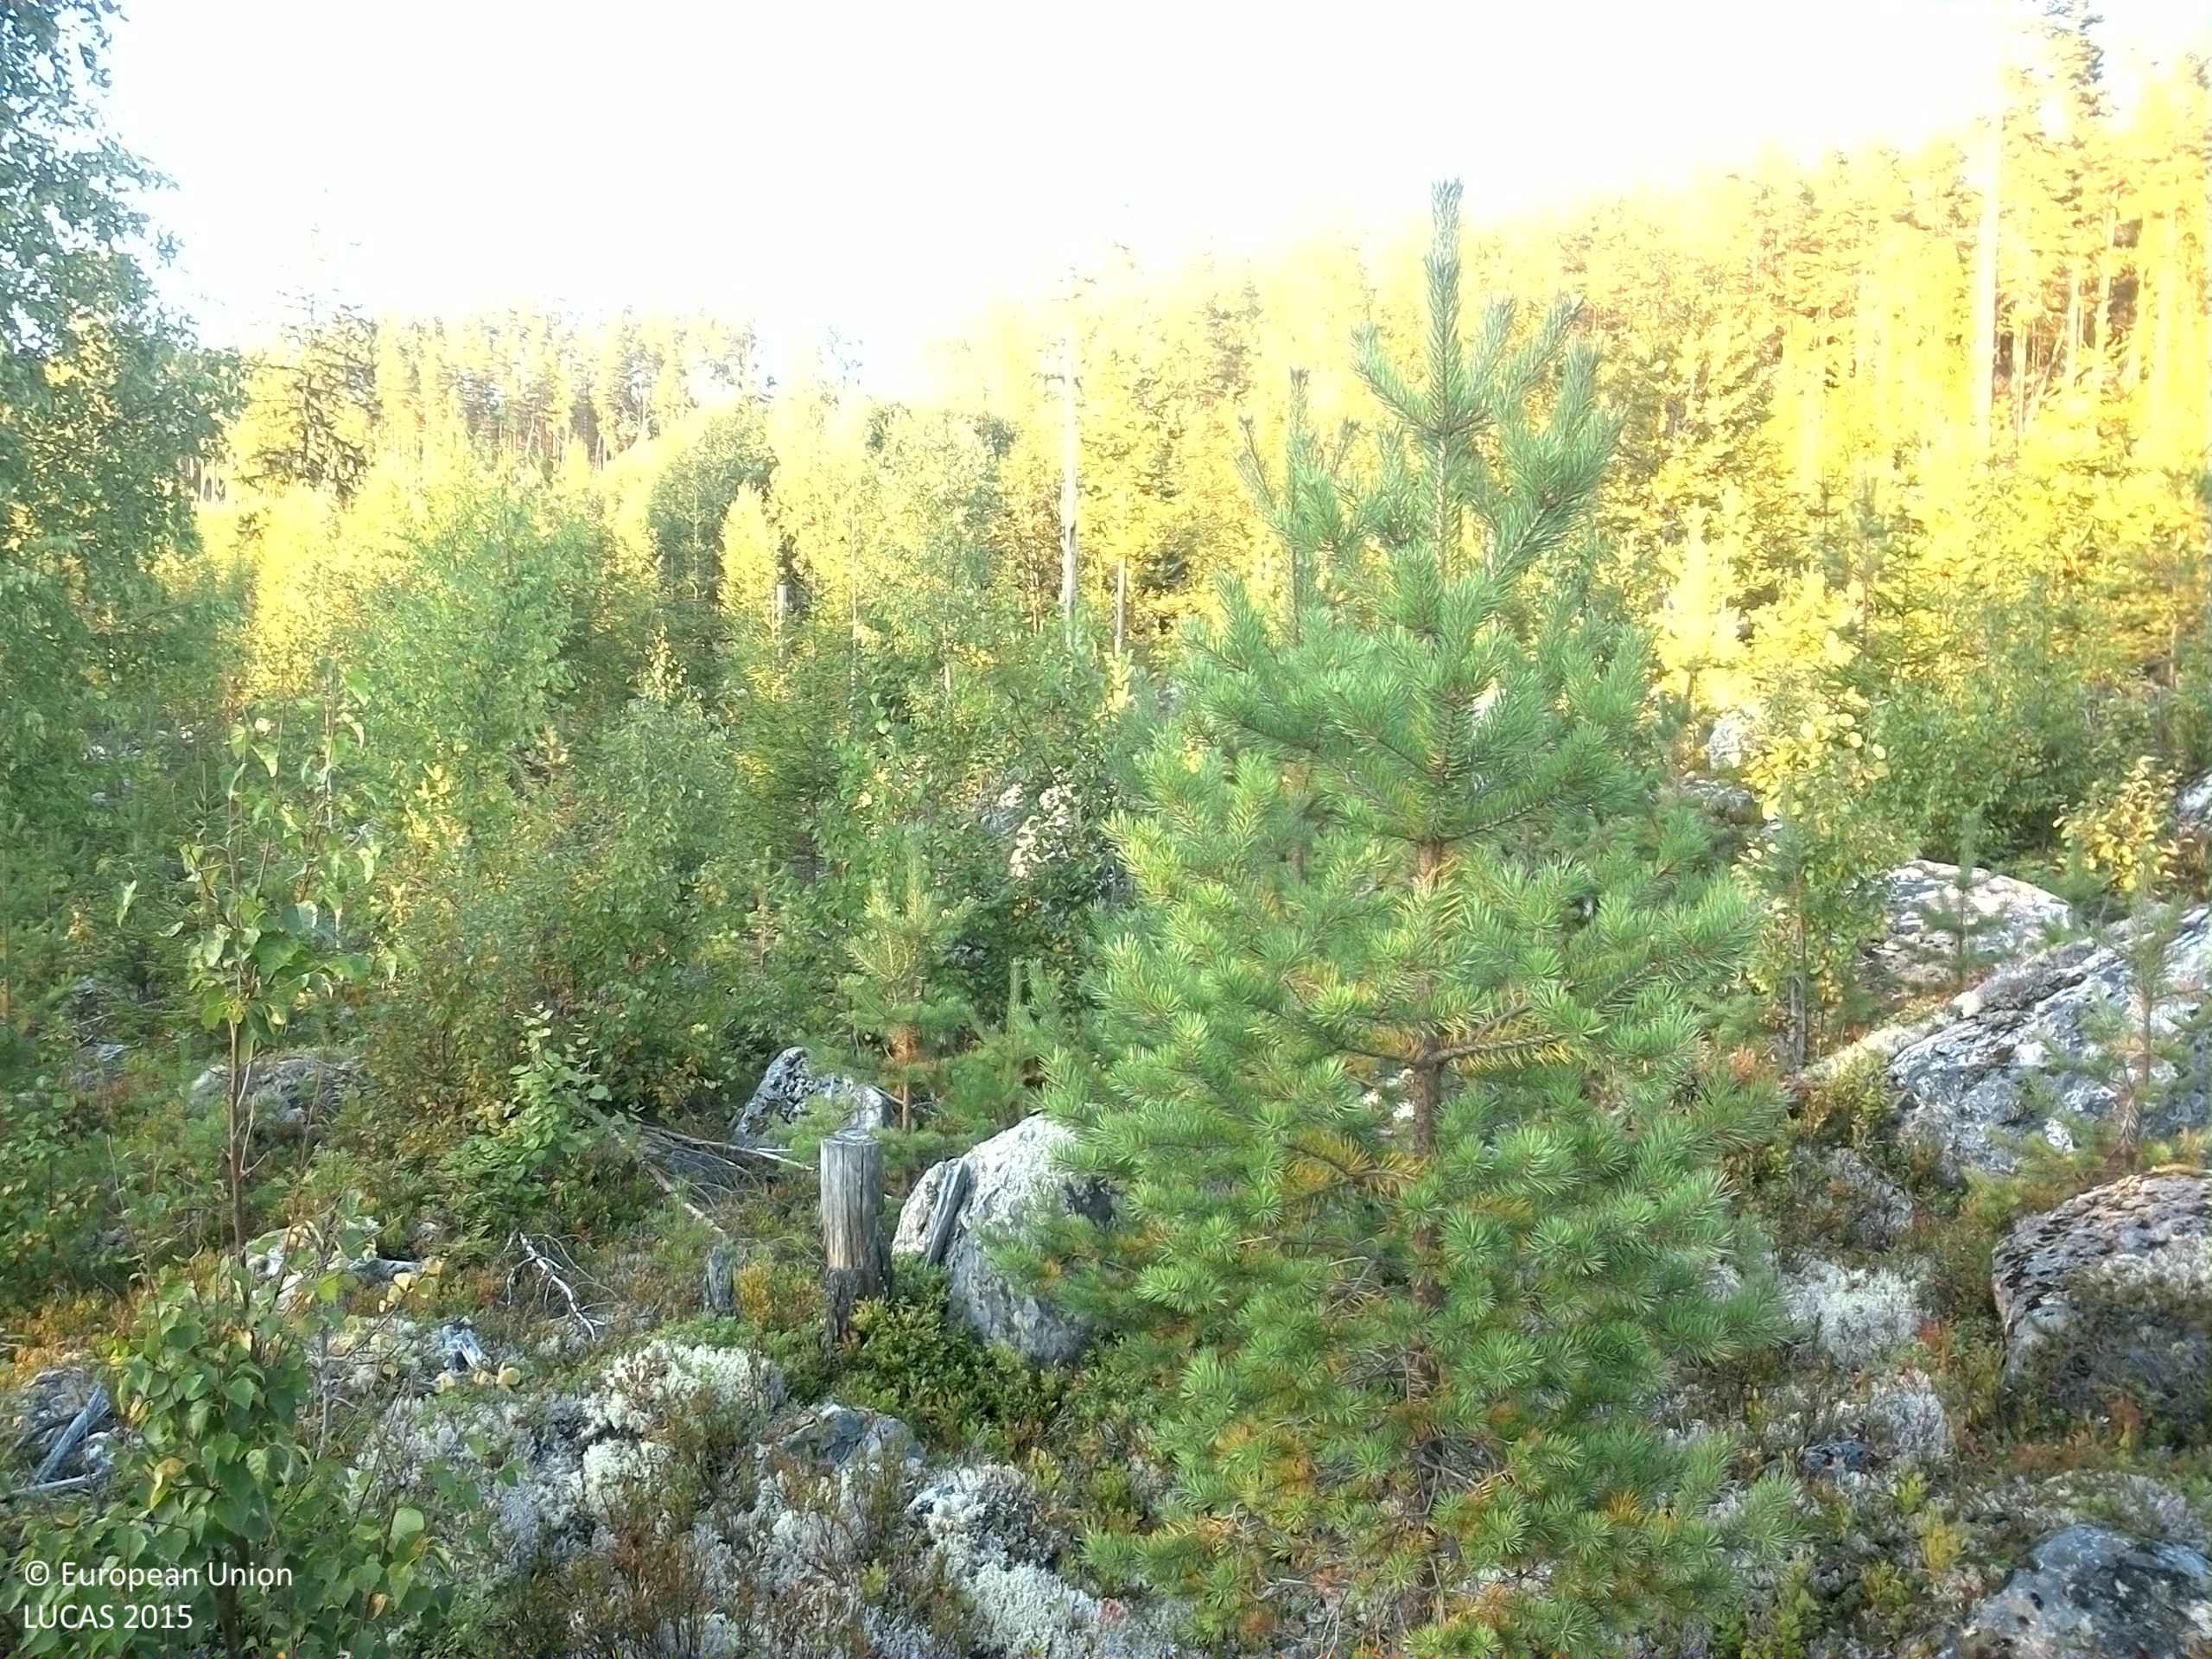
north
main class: Woodland
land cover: Pine dominated mixed woodland
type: boreal forest
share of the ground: 25 - 50 %
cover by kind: coniferous forest trees 30 %, shrubs 30 %, broadleaved forest trees 15 %, consolidated bare surface 15 %, lichens and mosses 10 %
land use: Forestry
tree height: < 5 m
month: September
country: SE
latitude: 61.6481
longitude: 15.4010
